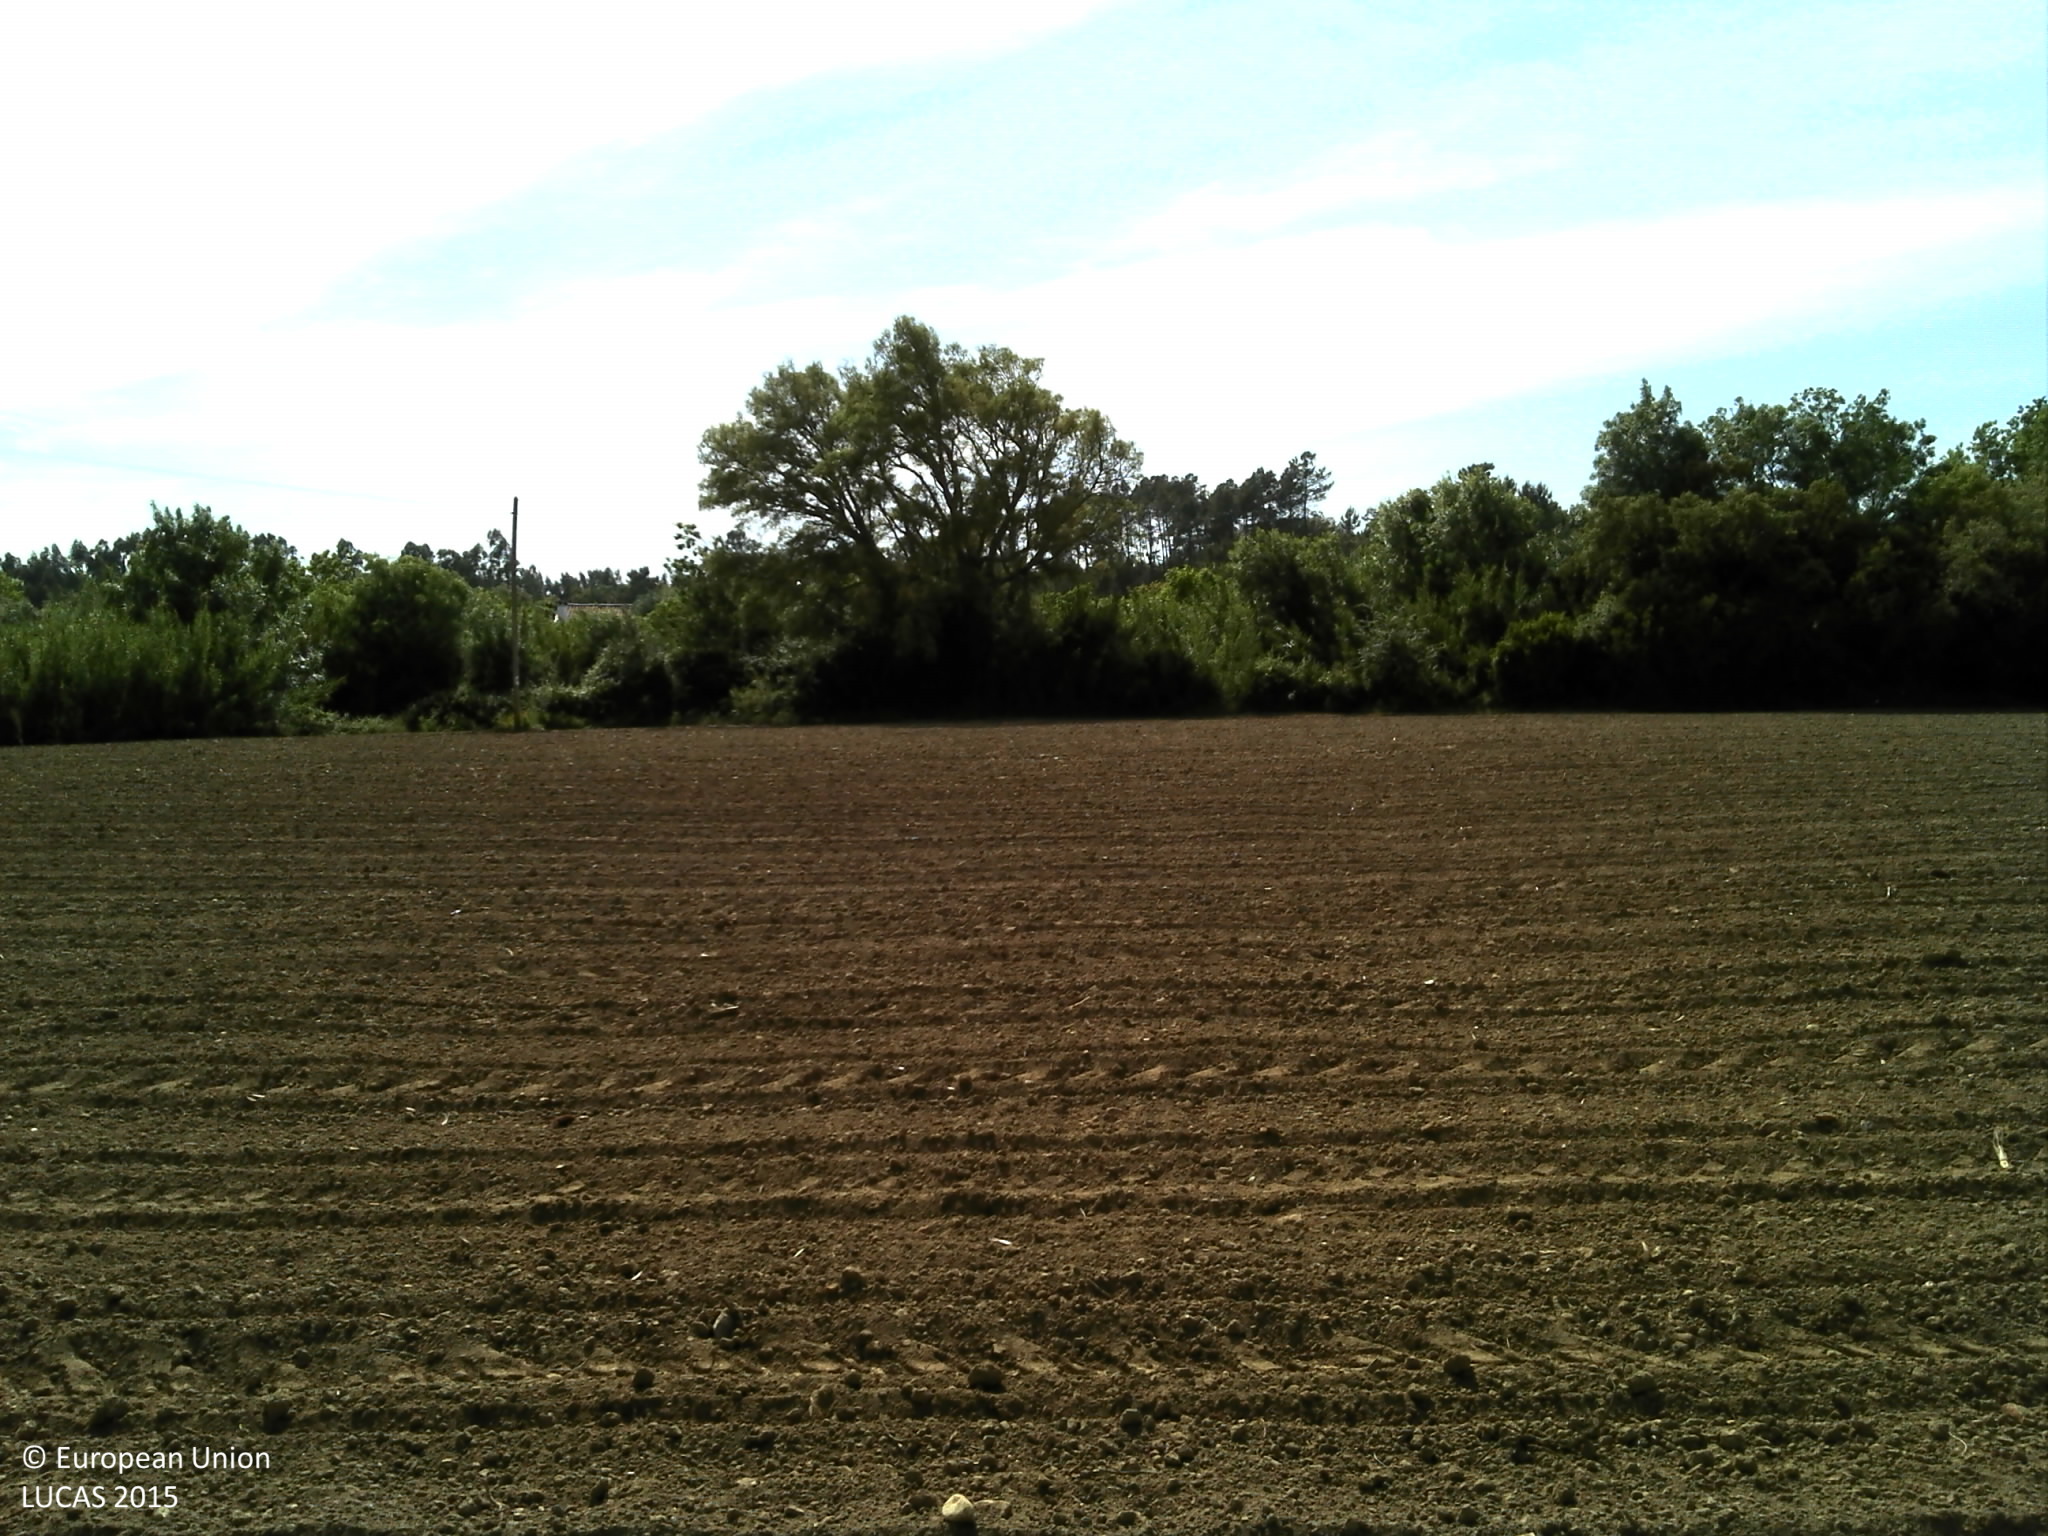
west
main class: Cropland
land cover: Maize
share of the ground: < 10 %
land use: Agriculture (excluding fallow land and kitchen gardens)
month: May
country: PT
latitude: 39.5900
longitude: -8.3632
